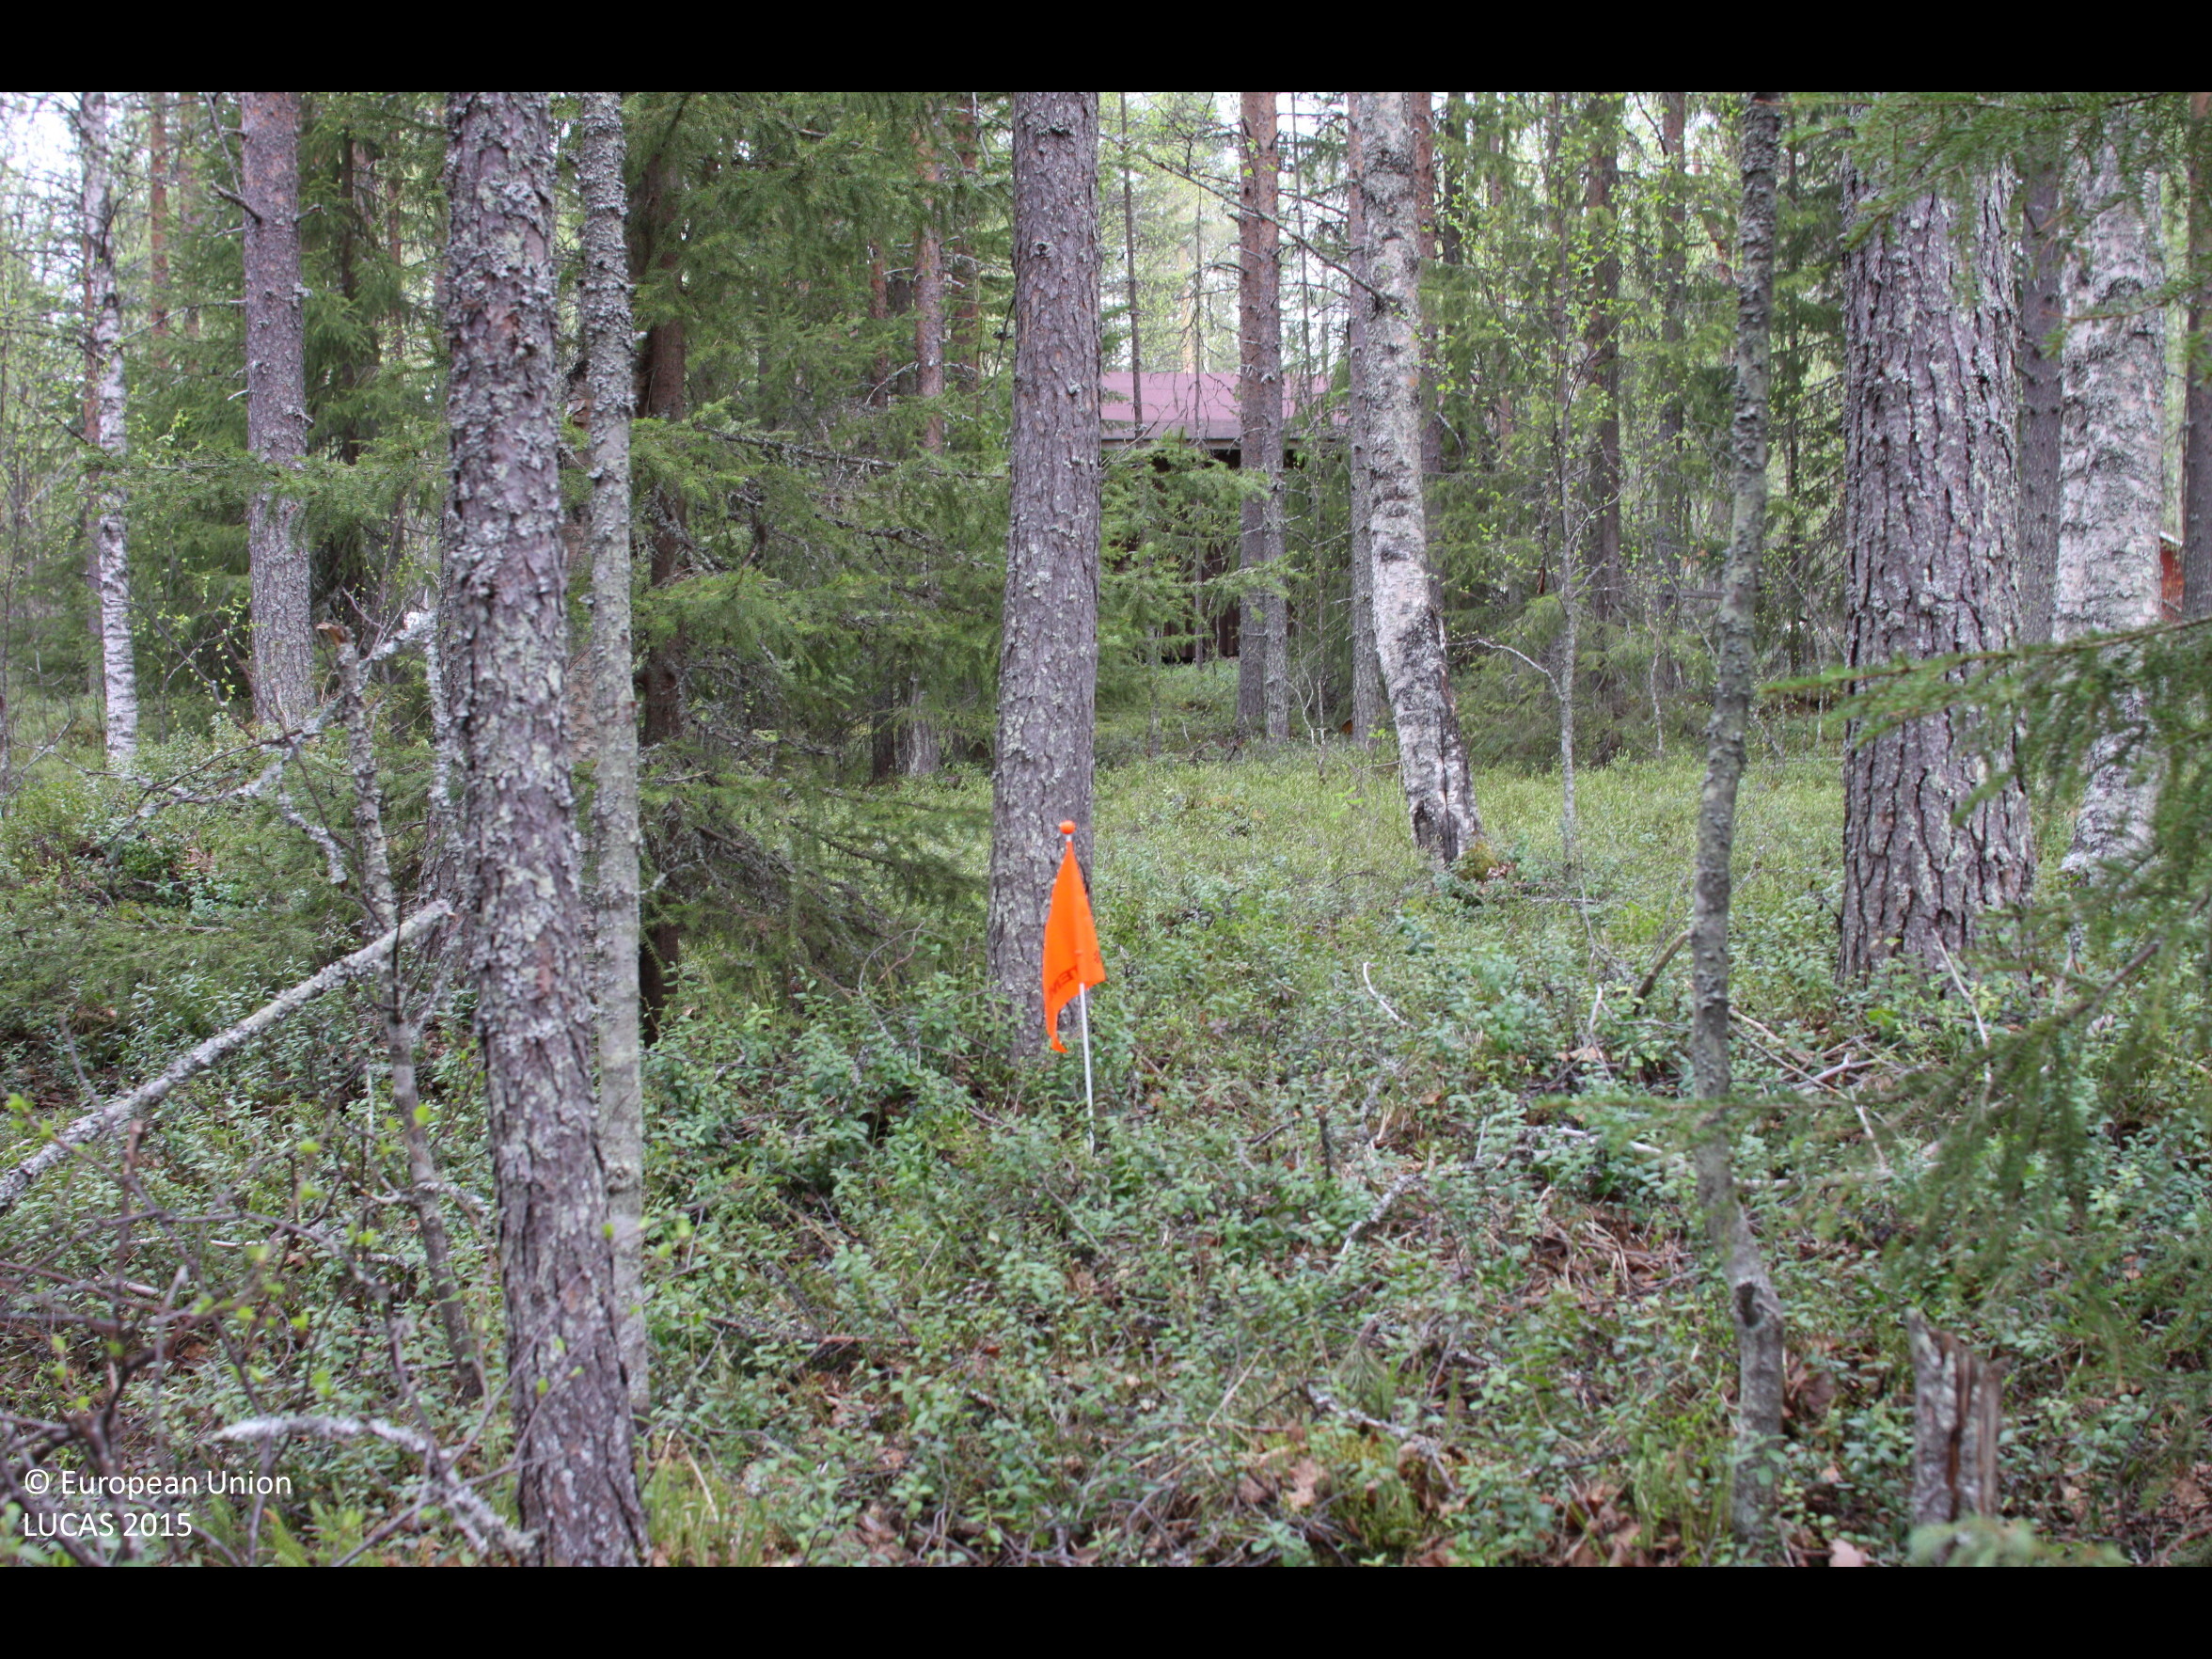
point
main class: Woodland
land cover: Pine dominated mixed woodland
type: boreal forest
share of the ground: > 75 %
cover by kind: coniferous forest trees 45 %, broadleaved forest trees 40 %, shrubs 10 %, herbaceous plants 5 %
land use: Forestry
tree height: > 5 m
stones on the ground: < 10 %
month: May
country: FI
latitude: 66.0877
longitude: 28.4346
